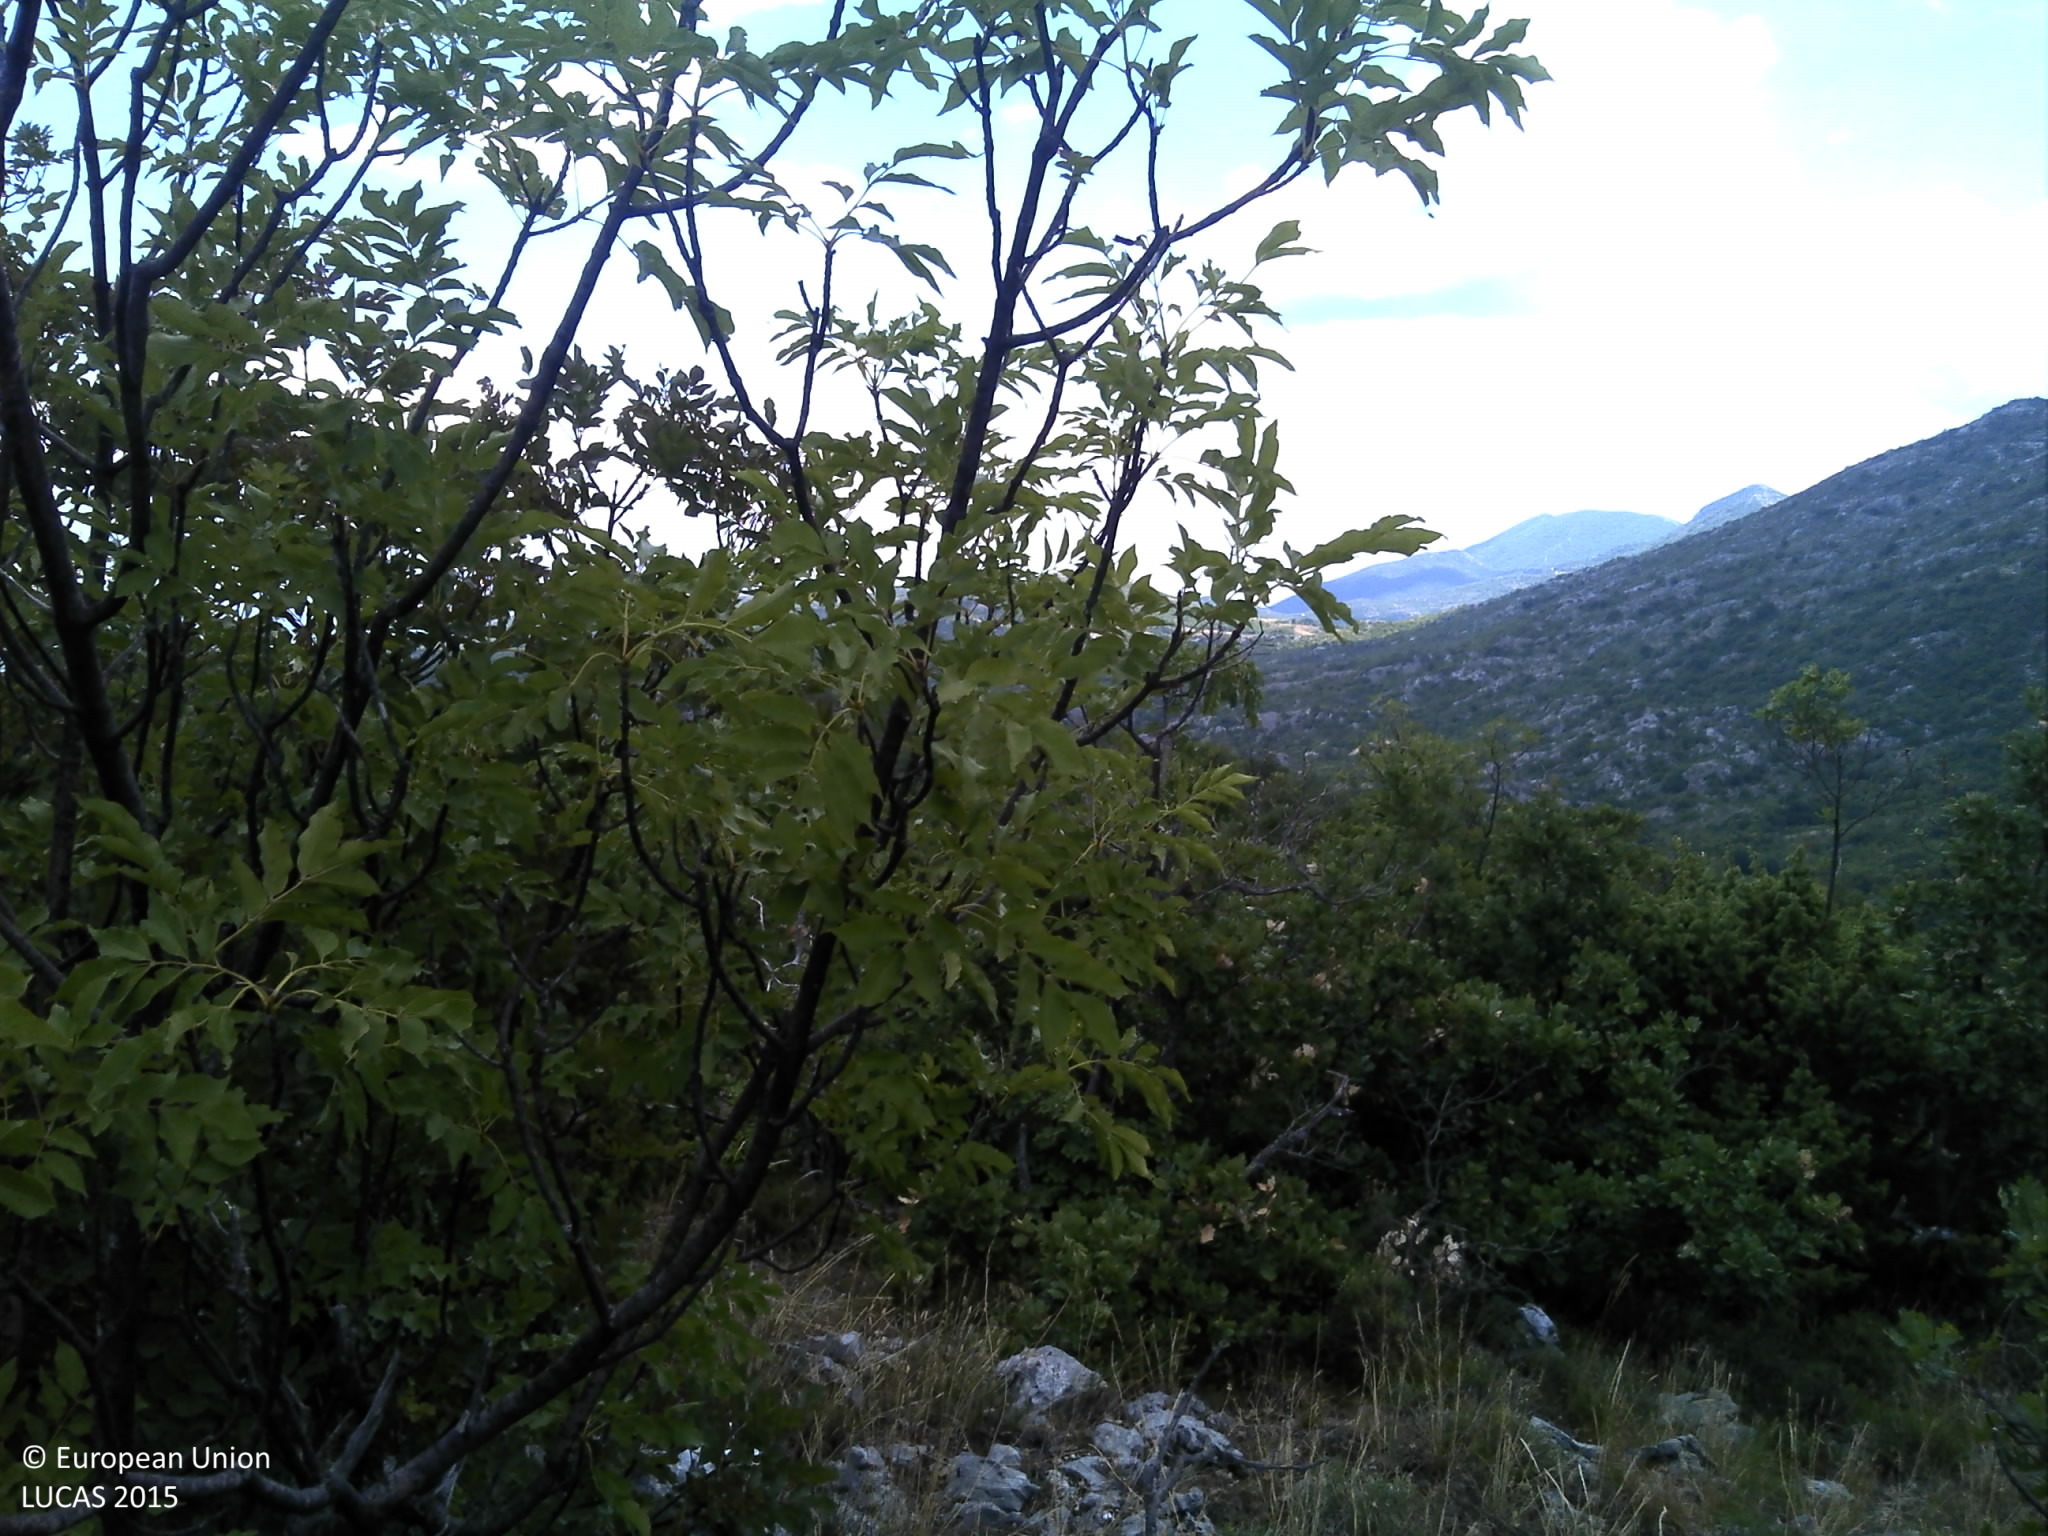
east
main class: Shrubland
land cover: Shrubland with sparse tree cover
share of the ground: > 75 %
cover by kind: shrubs 65 %, herbaceous plants 15 %, unconsolidated bare surface 10 %, broadleaved forest trees 5 %, consolidated bare surface 5 %
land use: Semi-natural and natural areas not in use
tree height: < 5 m
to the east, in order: Shrubland with sparse tree cover; Grassland without tree/shrub cover; Shrubland with sparse tree cover; Grassland without tree/shrub cover; Dry stone walls; Shrubland with sparse tree cover
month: August
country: HR
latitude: 43.3016
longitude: 17.2274
